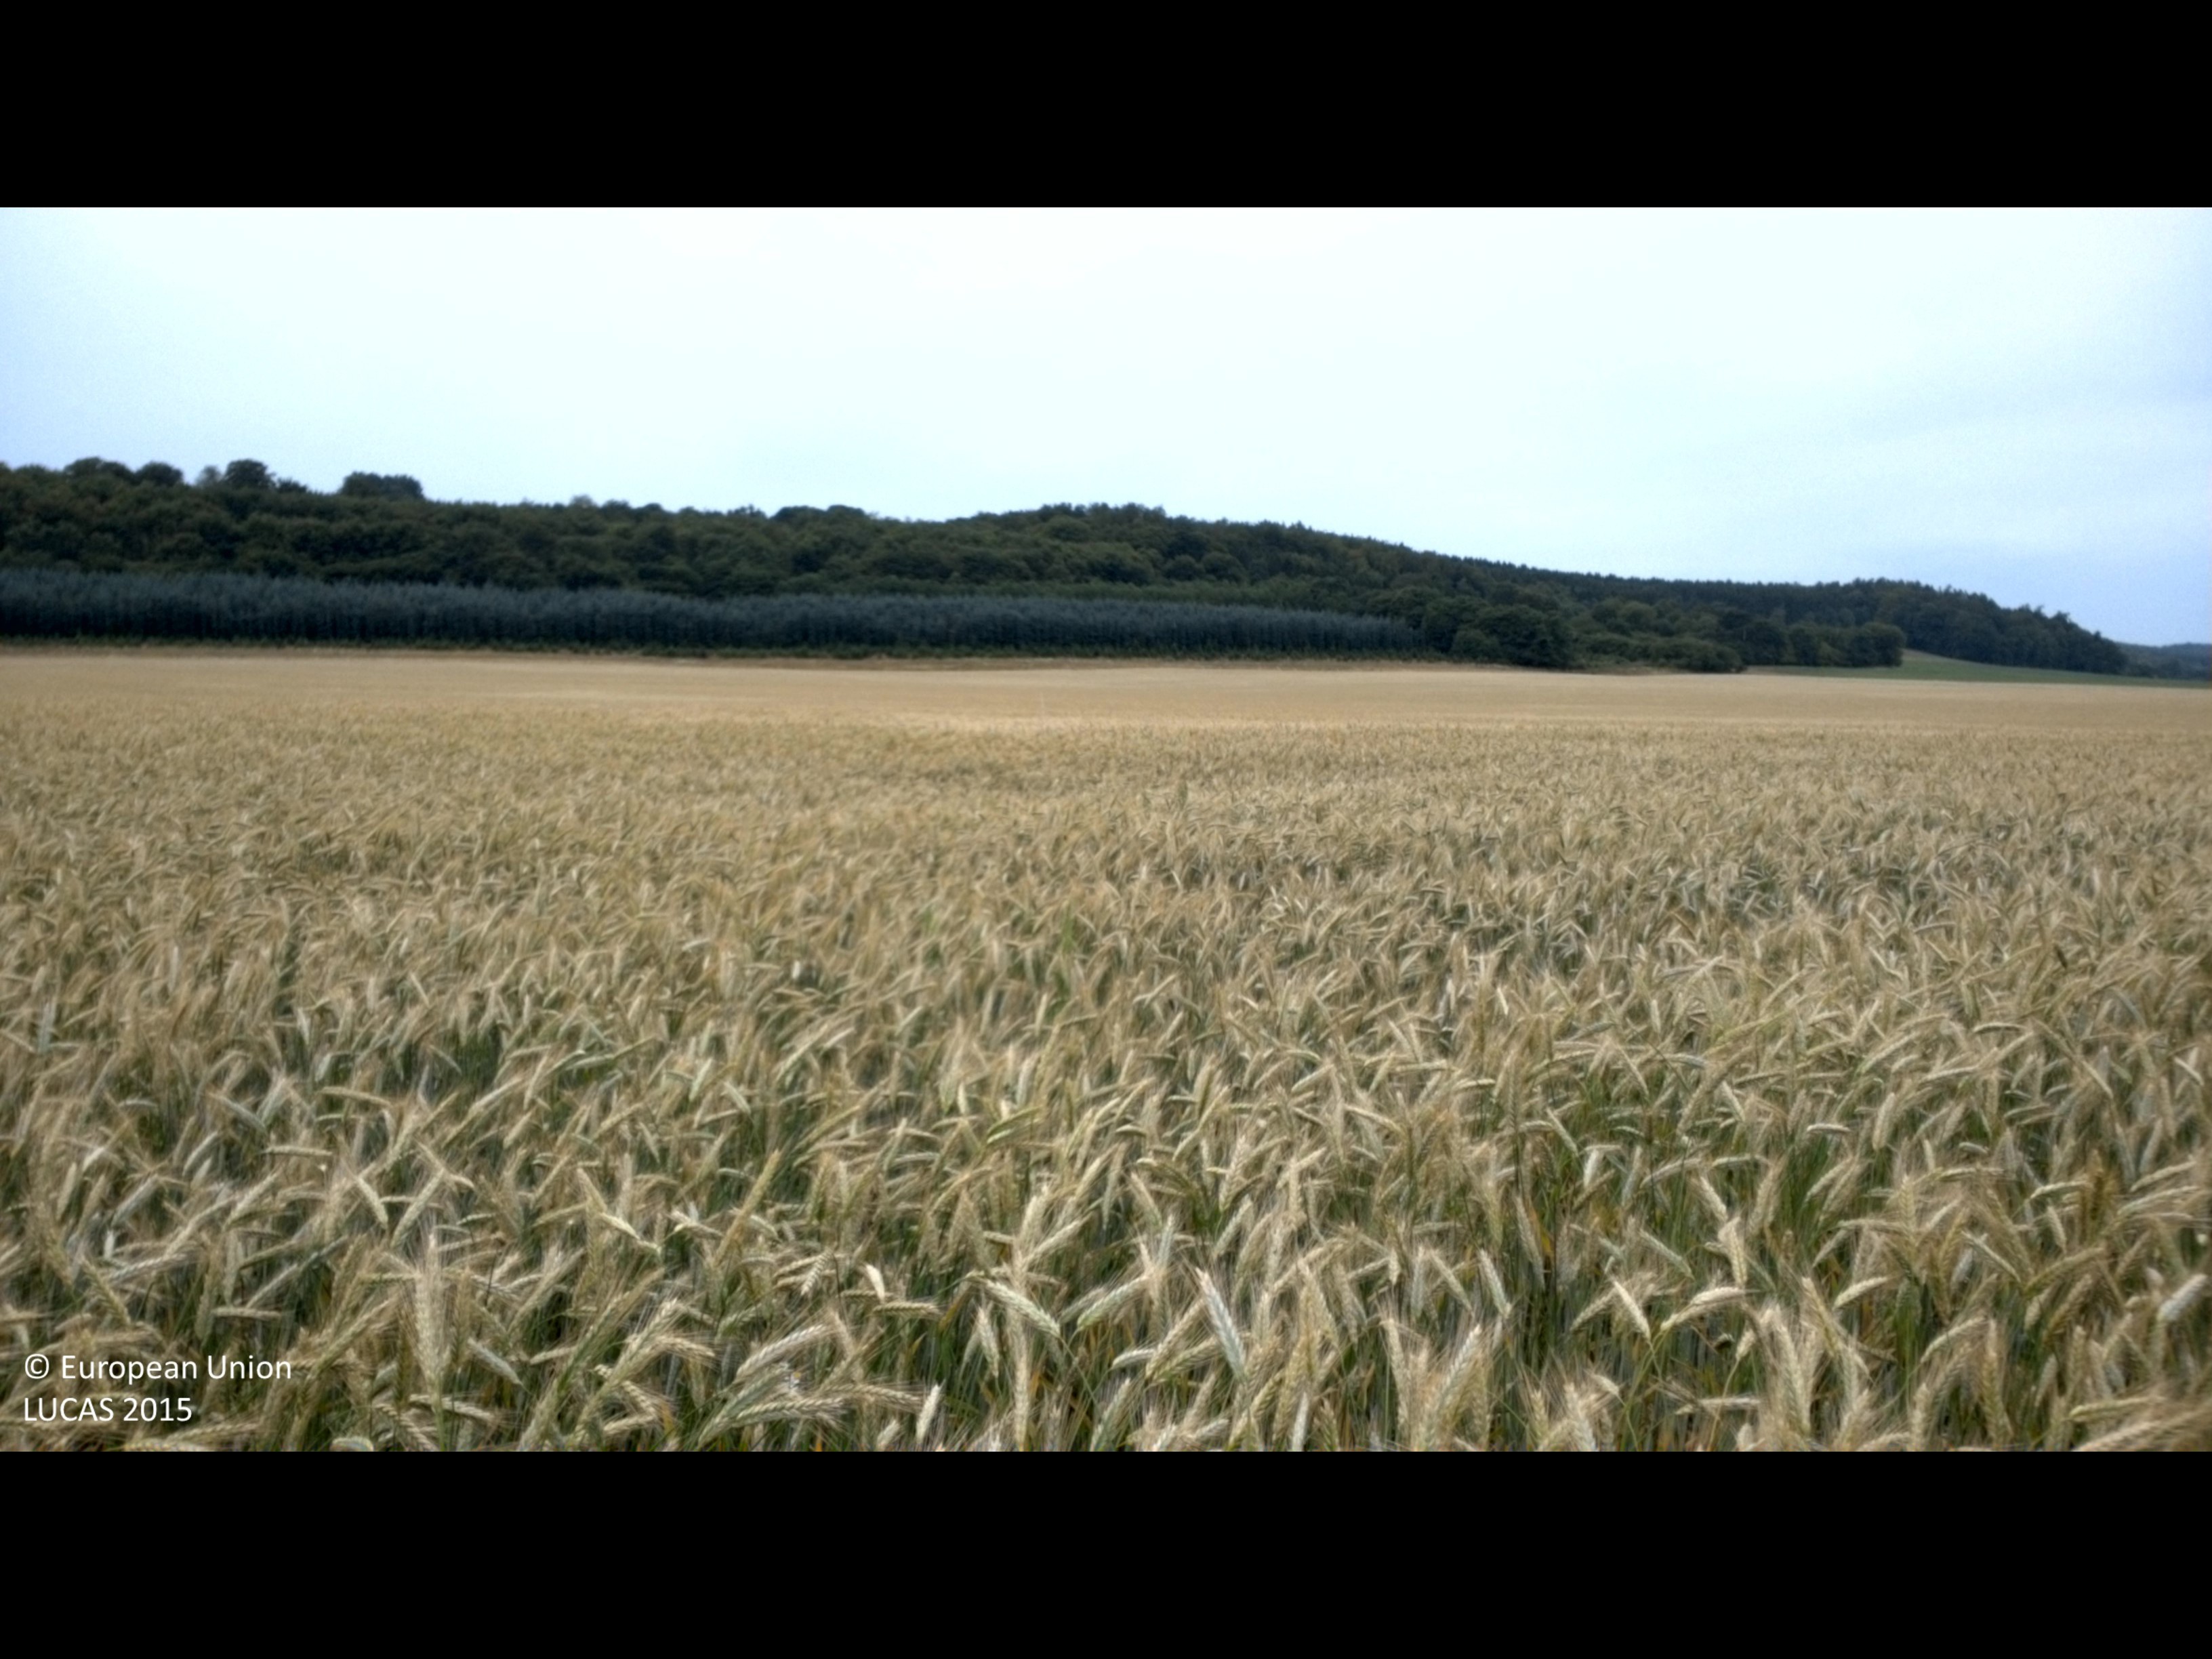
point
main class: Cropland
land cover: Rye
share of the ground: > 75 %
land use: Agriculture (excluding fallow land and kitchen gardens)
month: July
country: SE
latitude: 55.8532
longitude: 14.0715
